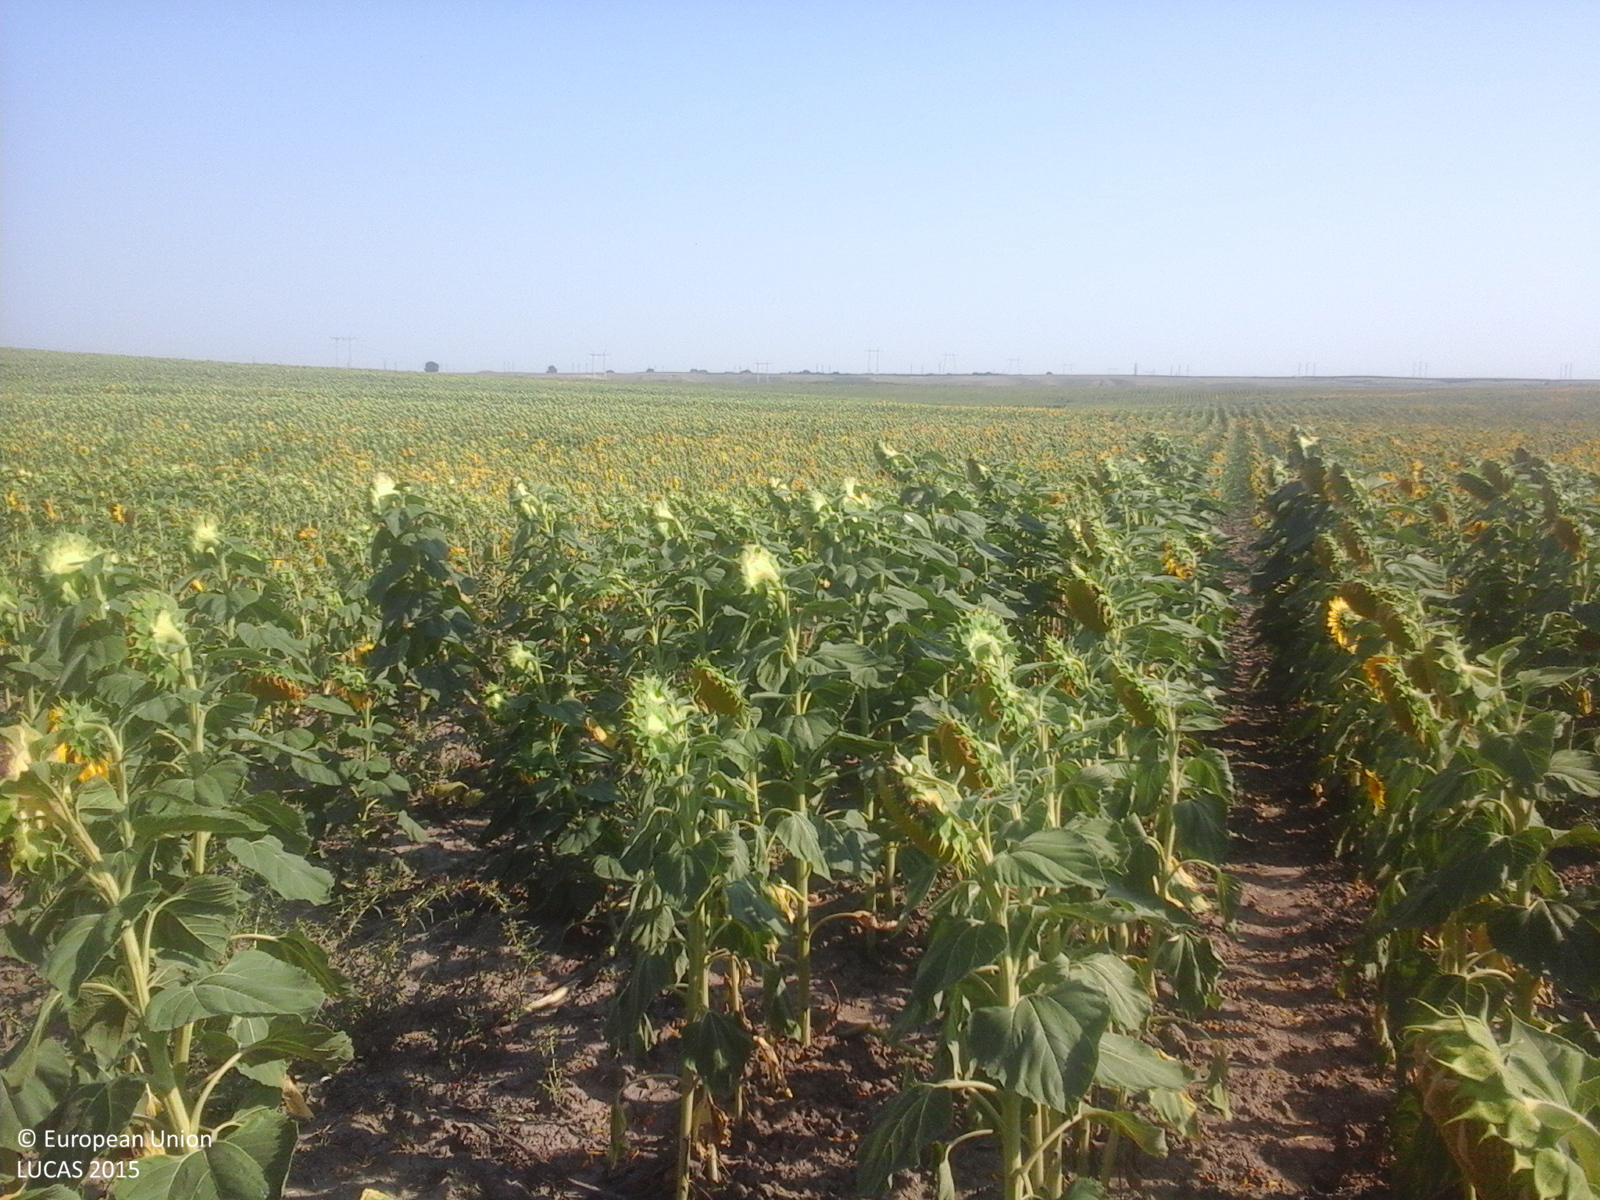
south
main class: Cropland
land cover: Sunflower
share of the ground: > 75 %
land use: Agriculture (excluding fallow land and kitchen gardens)
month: July
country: RO
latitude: 44.9155
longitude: 27.6975
